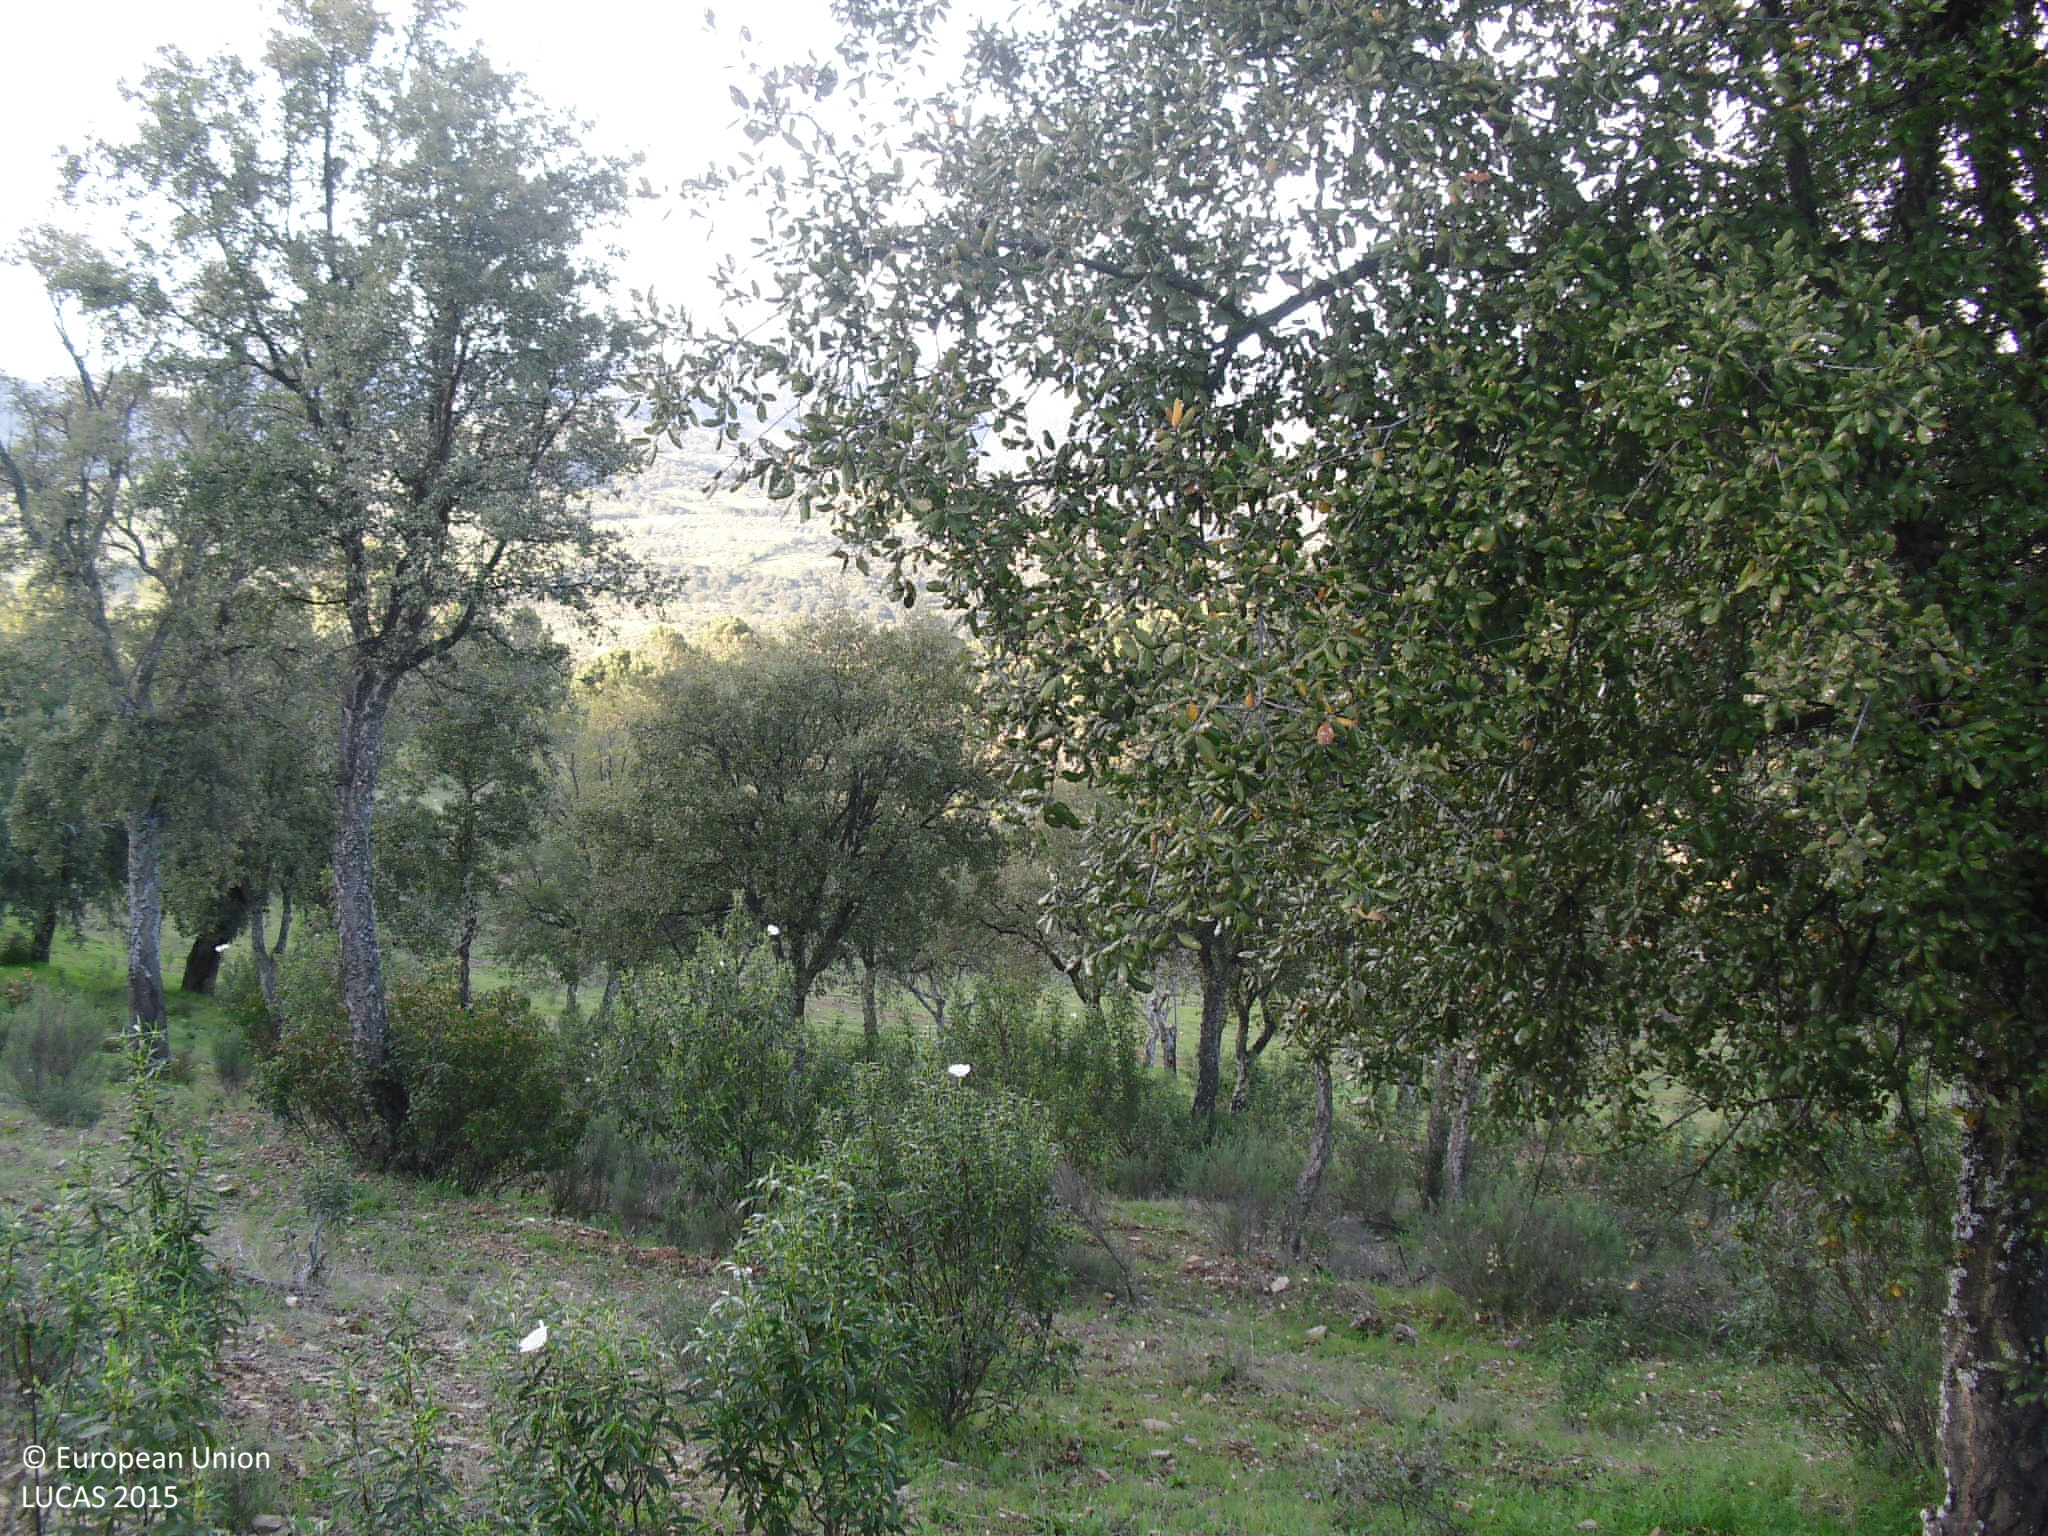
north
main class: Woodland
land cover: Broadleaved woodland
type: broadleaved evergreen forest
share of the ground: 10 - 25 %
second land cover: Shrubland without tree cover
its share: > 75 %
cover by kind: shrubs 70 %, broadleaved forest trees 20 %, herbaceous plants 10 %
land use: Forestry
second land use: Agriculture (excluding fallow land and kitchen gardens)
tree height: > 5 m
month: April
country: ES
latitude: 39.4269
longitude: -5.3002
